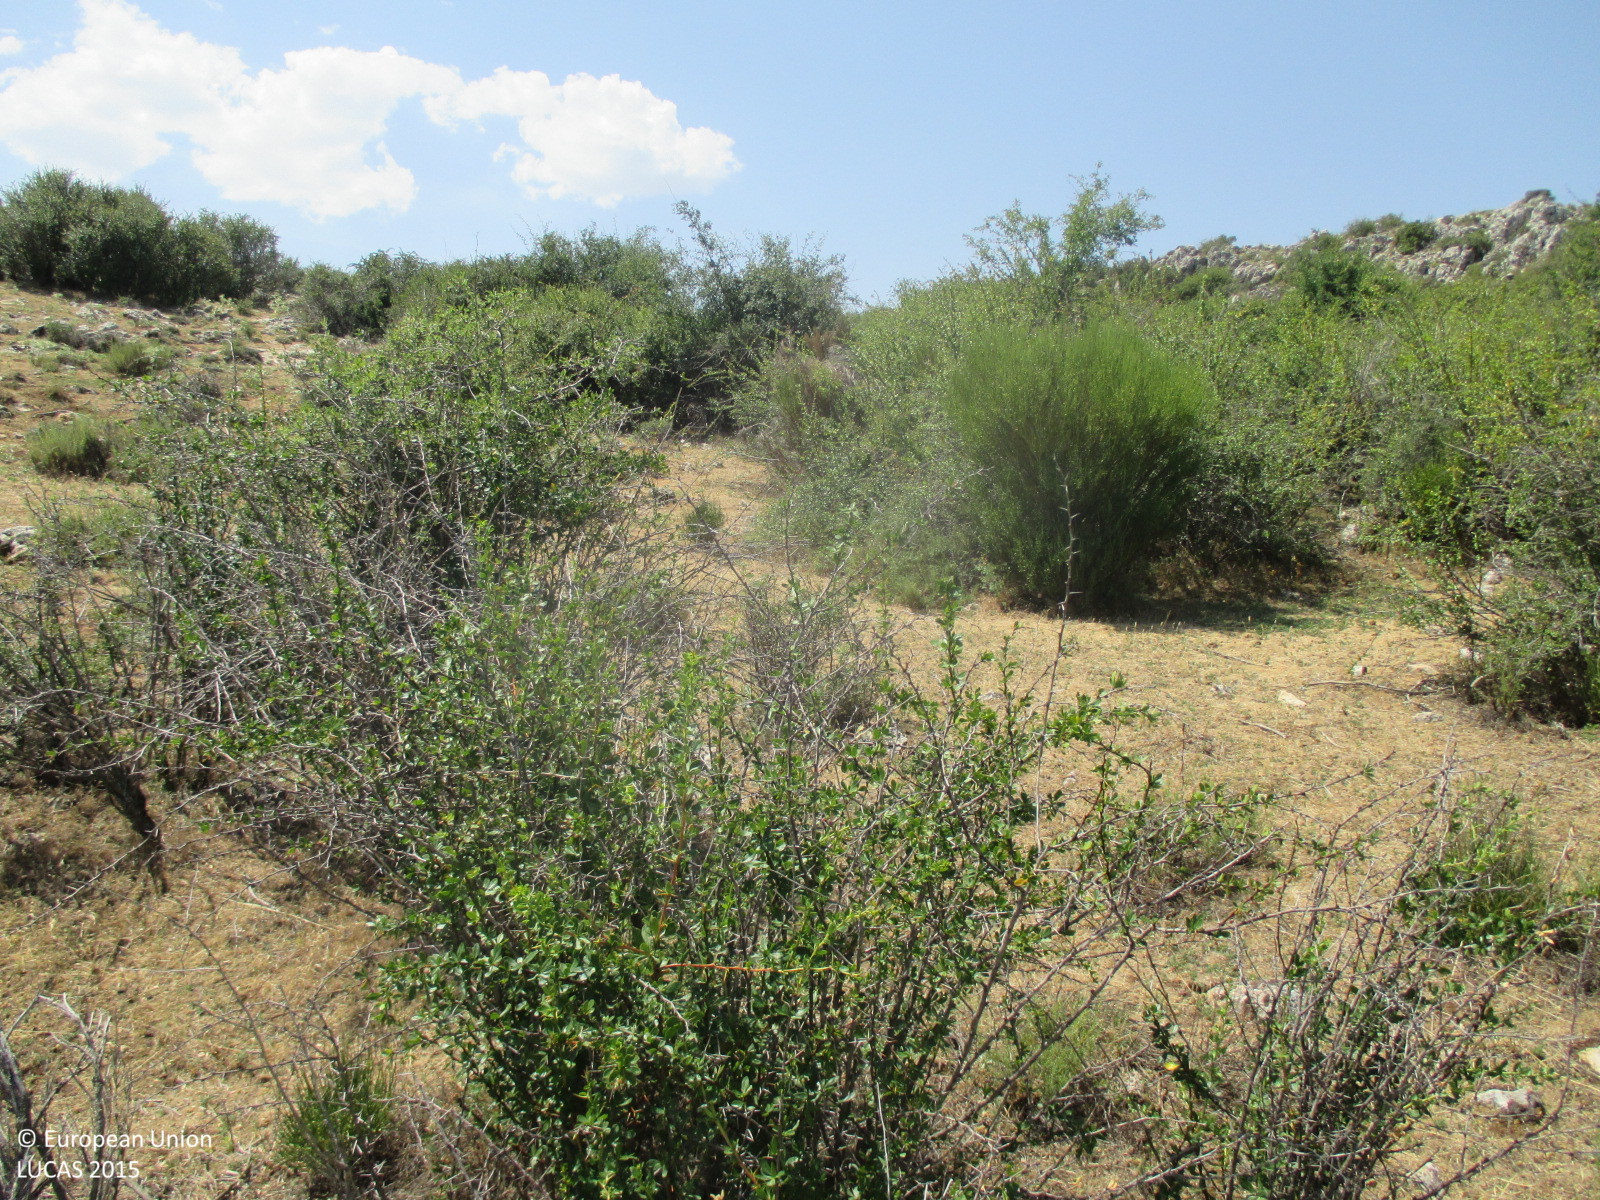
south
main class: Shrubland
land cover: Shrubland without tree cover
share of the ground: 50 - 75 %
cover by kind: shrubs 60 %, consolidated bare surface 30 %, herbaceous plants 10 %
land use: Semi-natural and natural areas not in use
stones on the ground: < 10 %
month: July
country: ES
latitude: 38.0947
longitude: -2.4793
